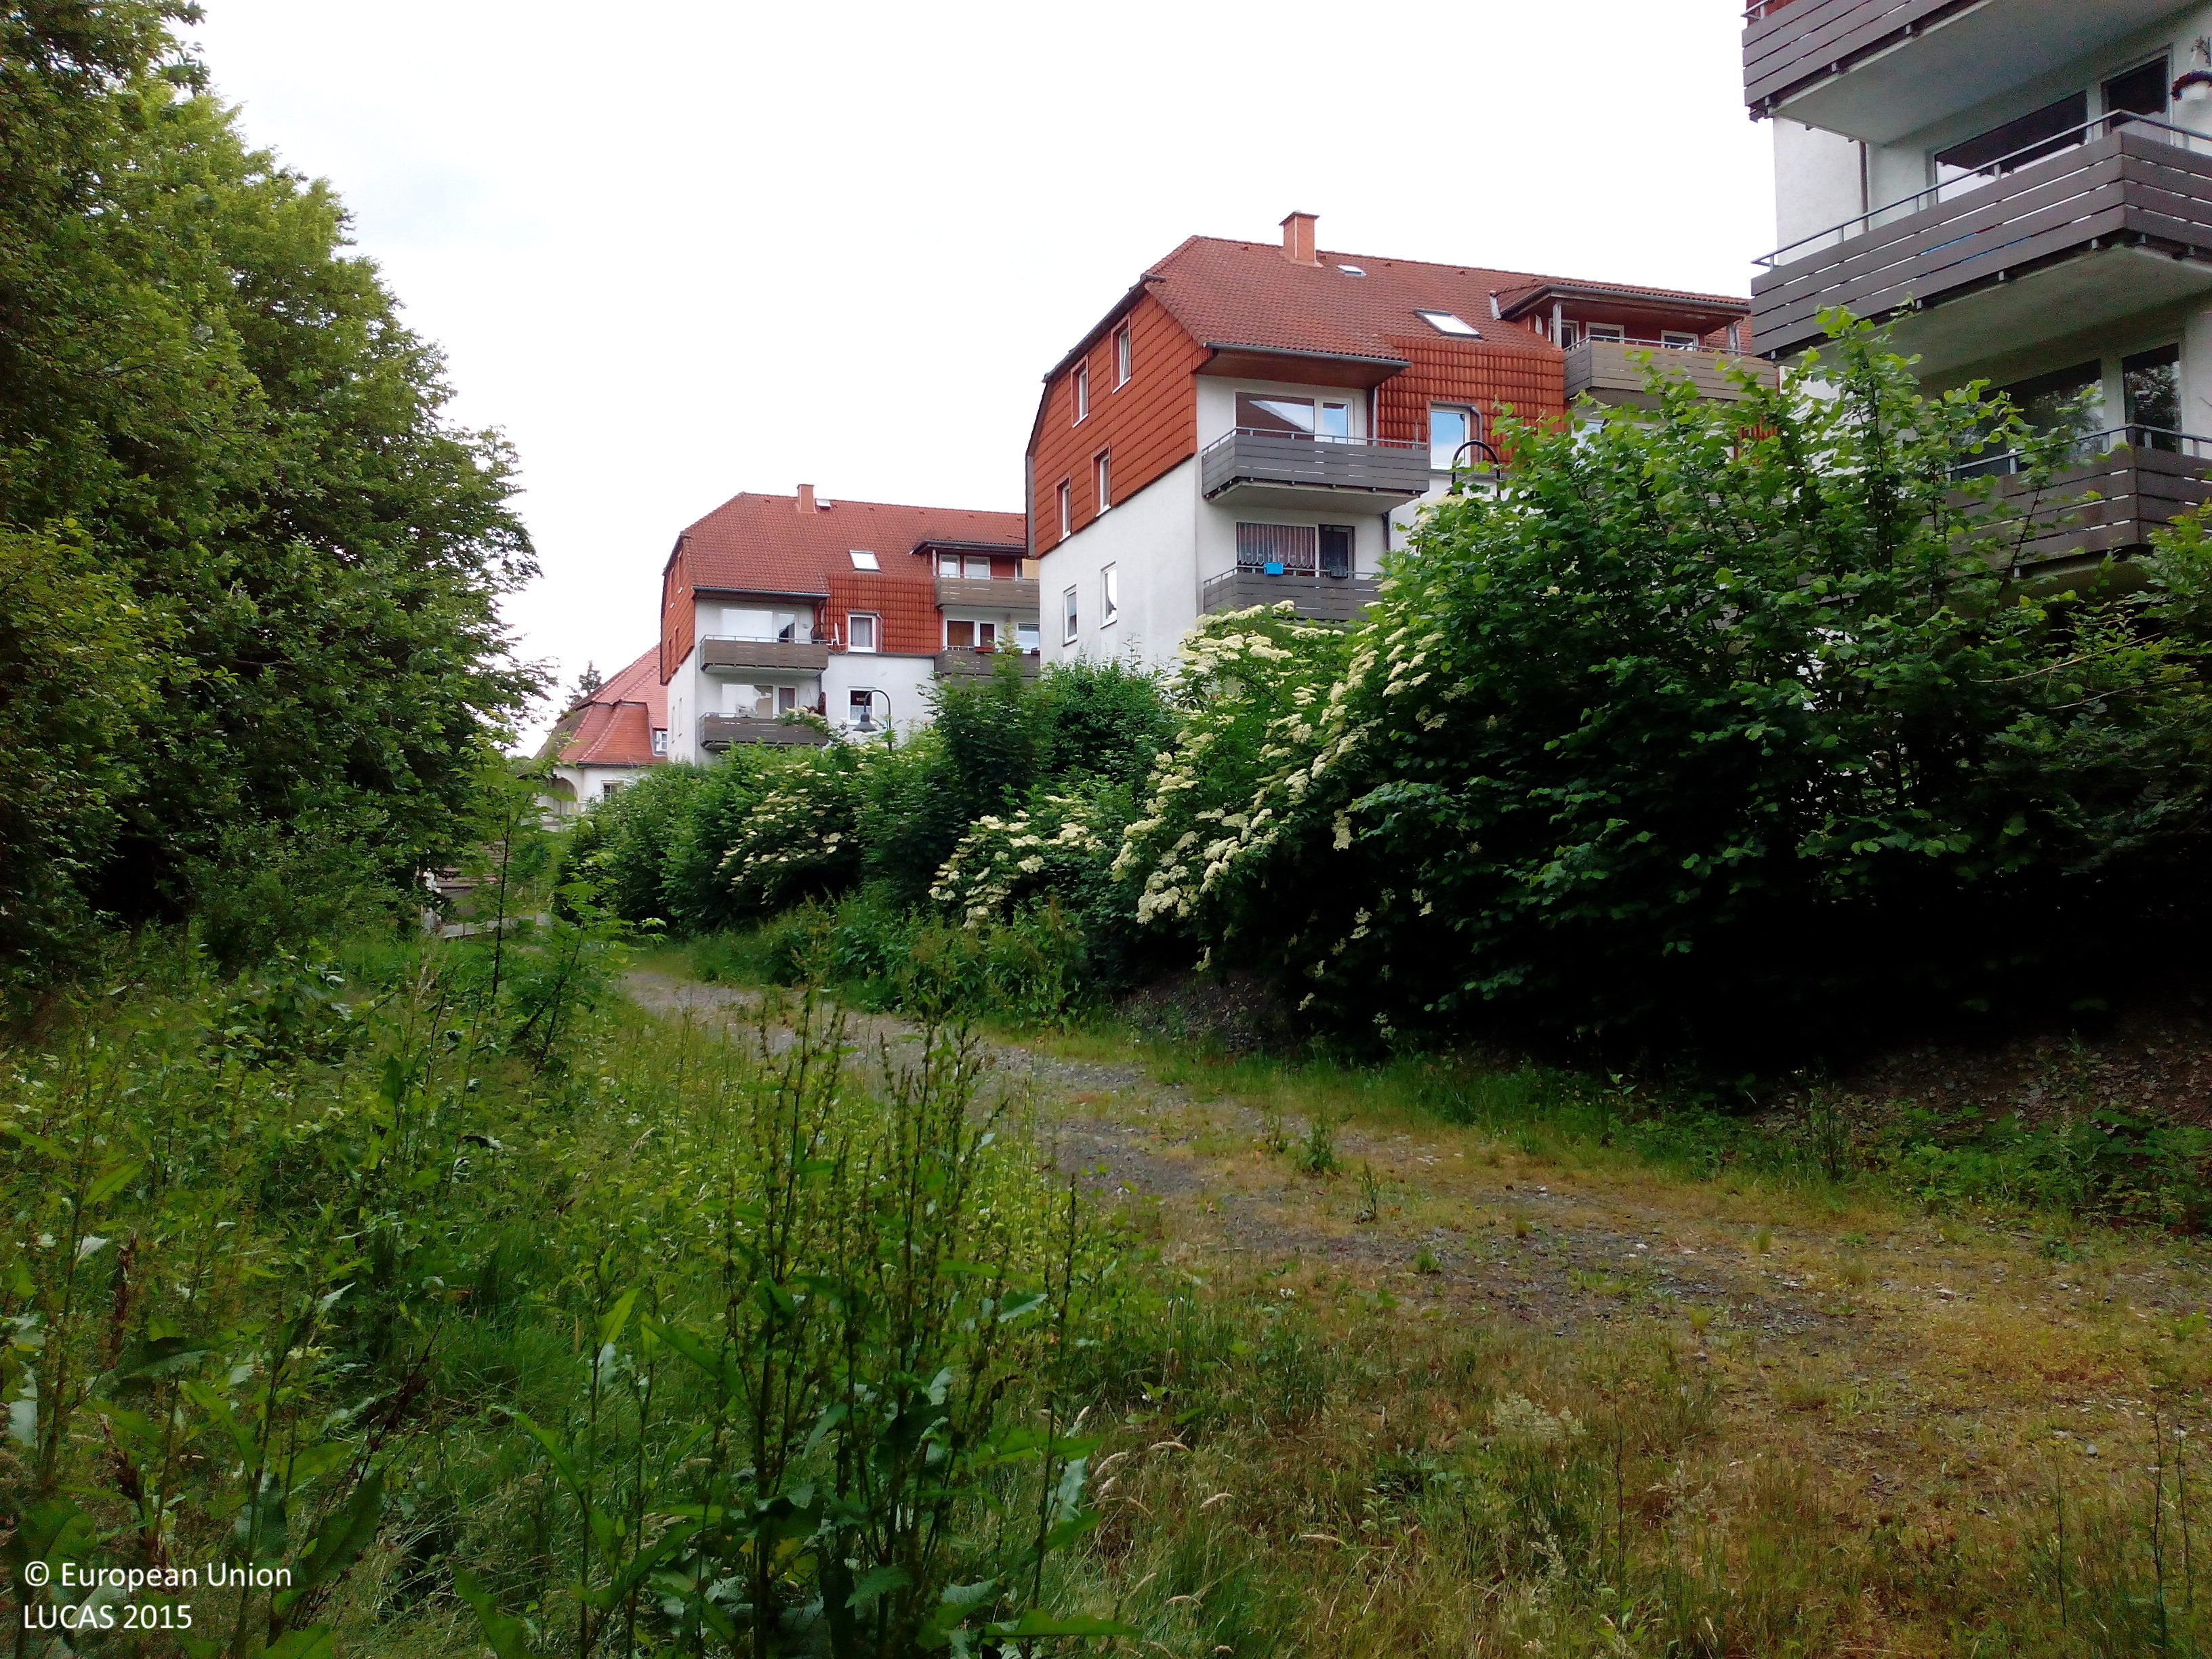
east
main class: Woodland
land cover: Broadleaved woodland
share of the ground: 50 - 75 %
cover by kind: broadleaved forest trees 70 %, herbaceous plants 30 %
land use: Residential
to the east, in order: Broadleaved woodland; Artificial constructions in urban areas
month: June
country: DE
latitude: 51.6579
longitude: 9.6387
